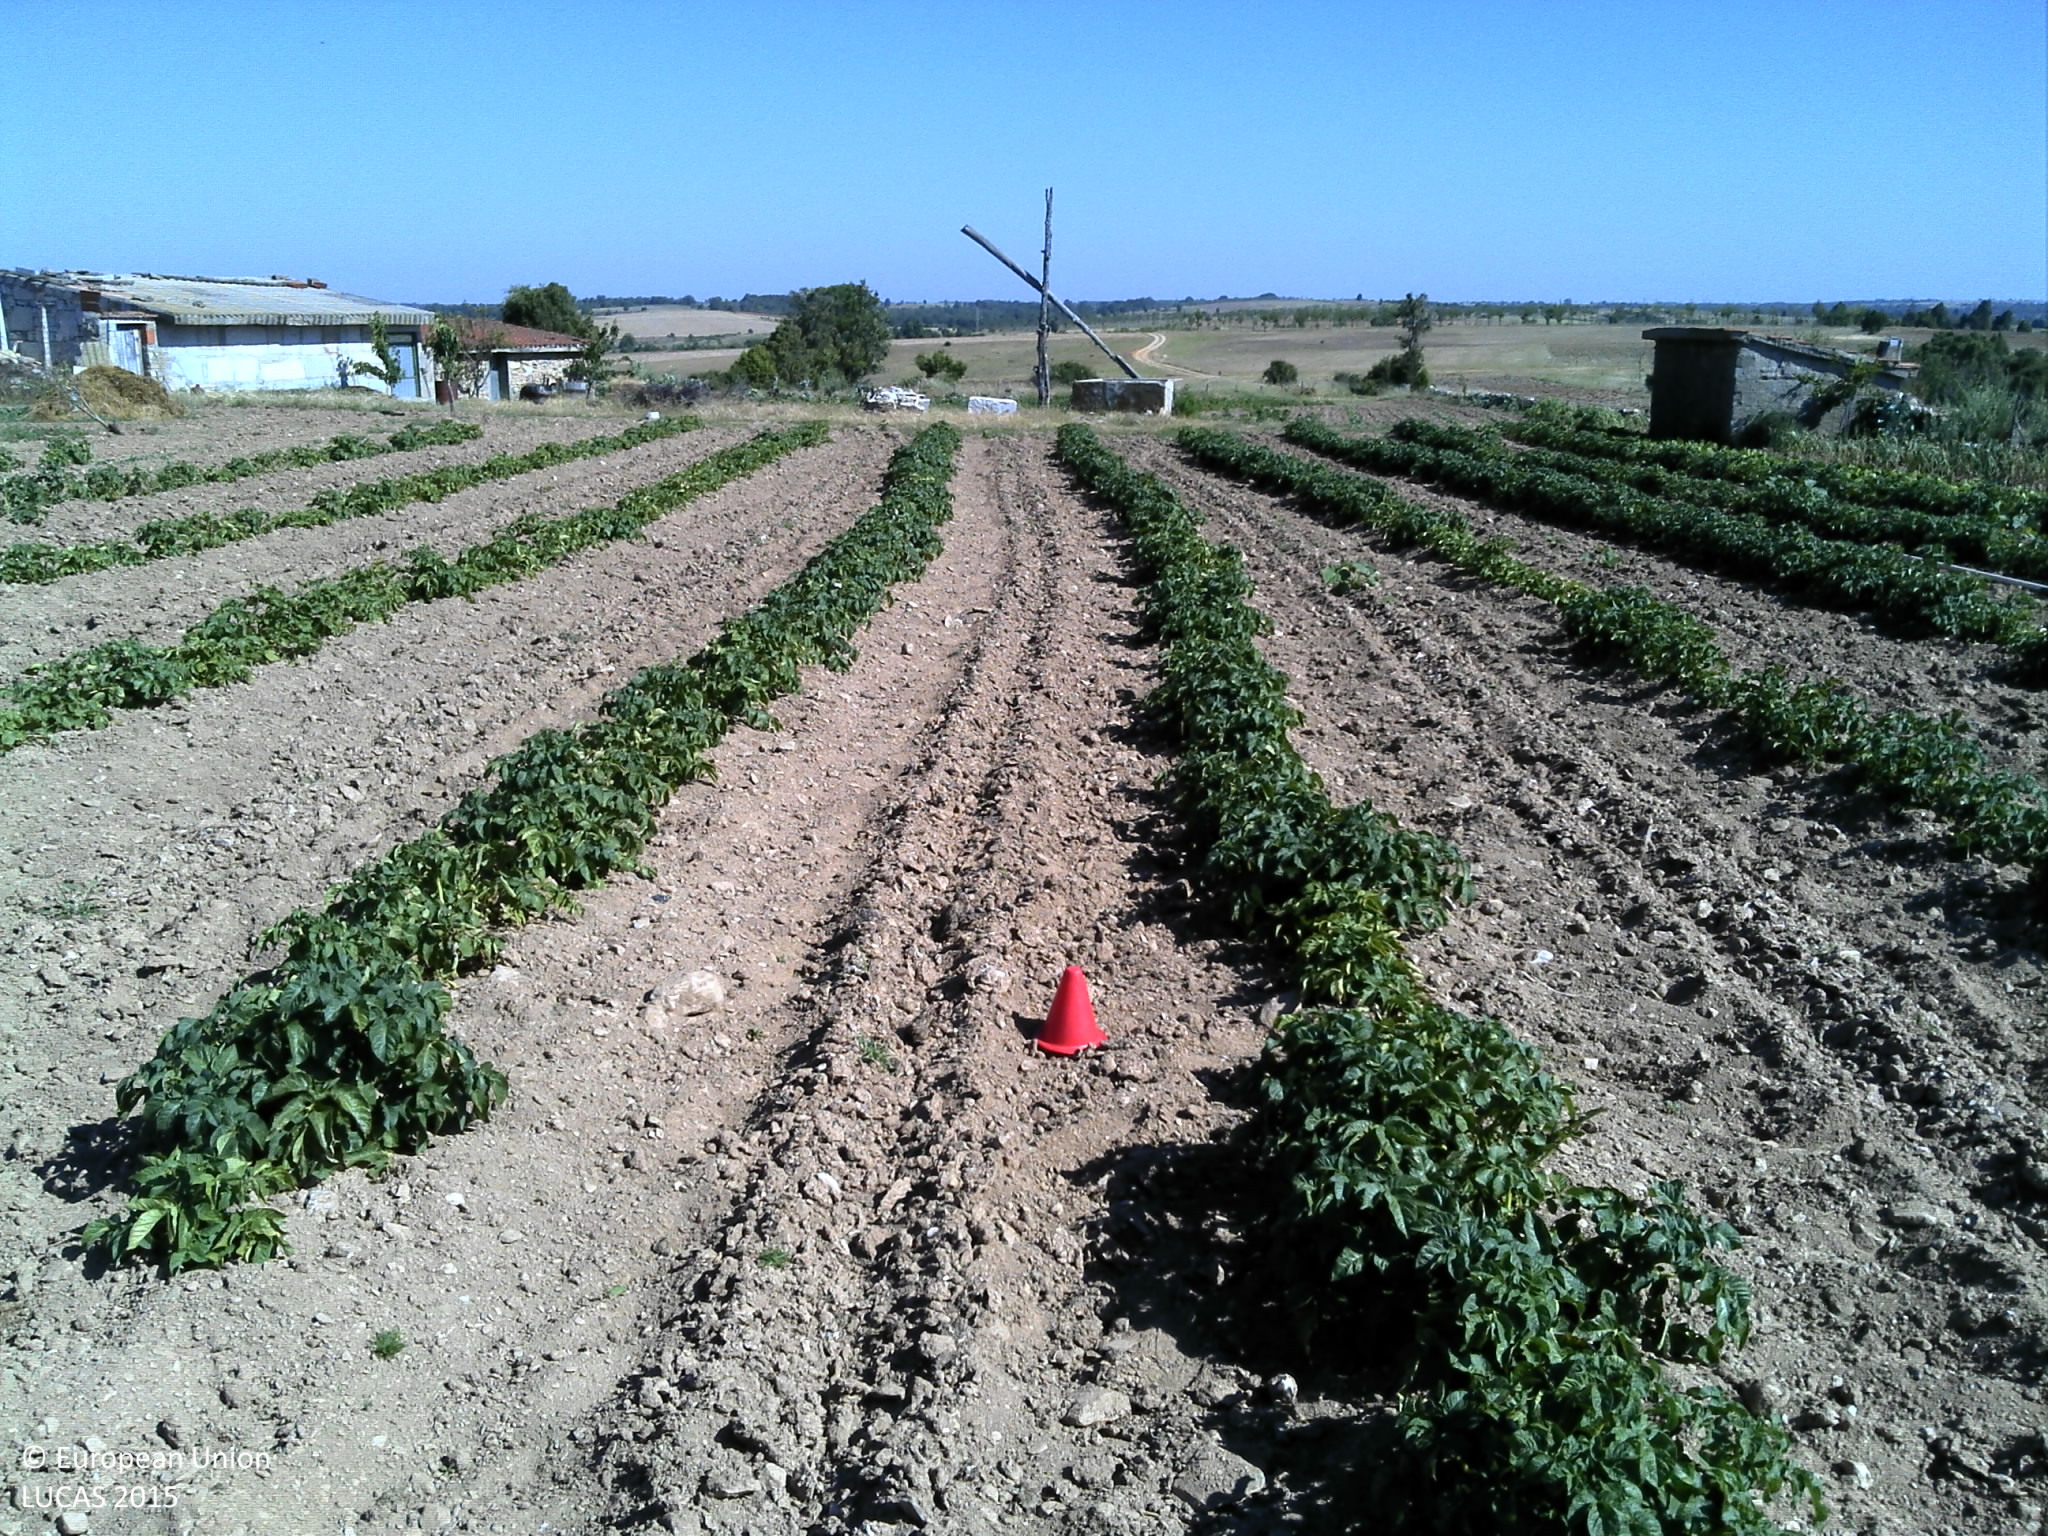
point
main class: Cropland
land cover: Potatoes
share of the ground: < 10 %
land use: Agriculture (excluding fallow land and kitchen gardens)
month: May
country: PT
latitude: 41.4667
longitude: -6.3221
